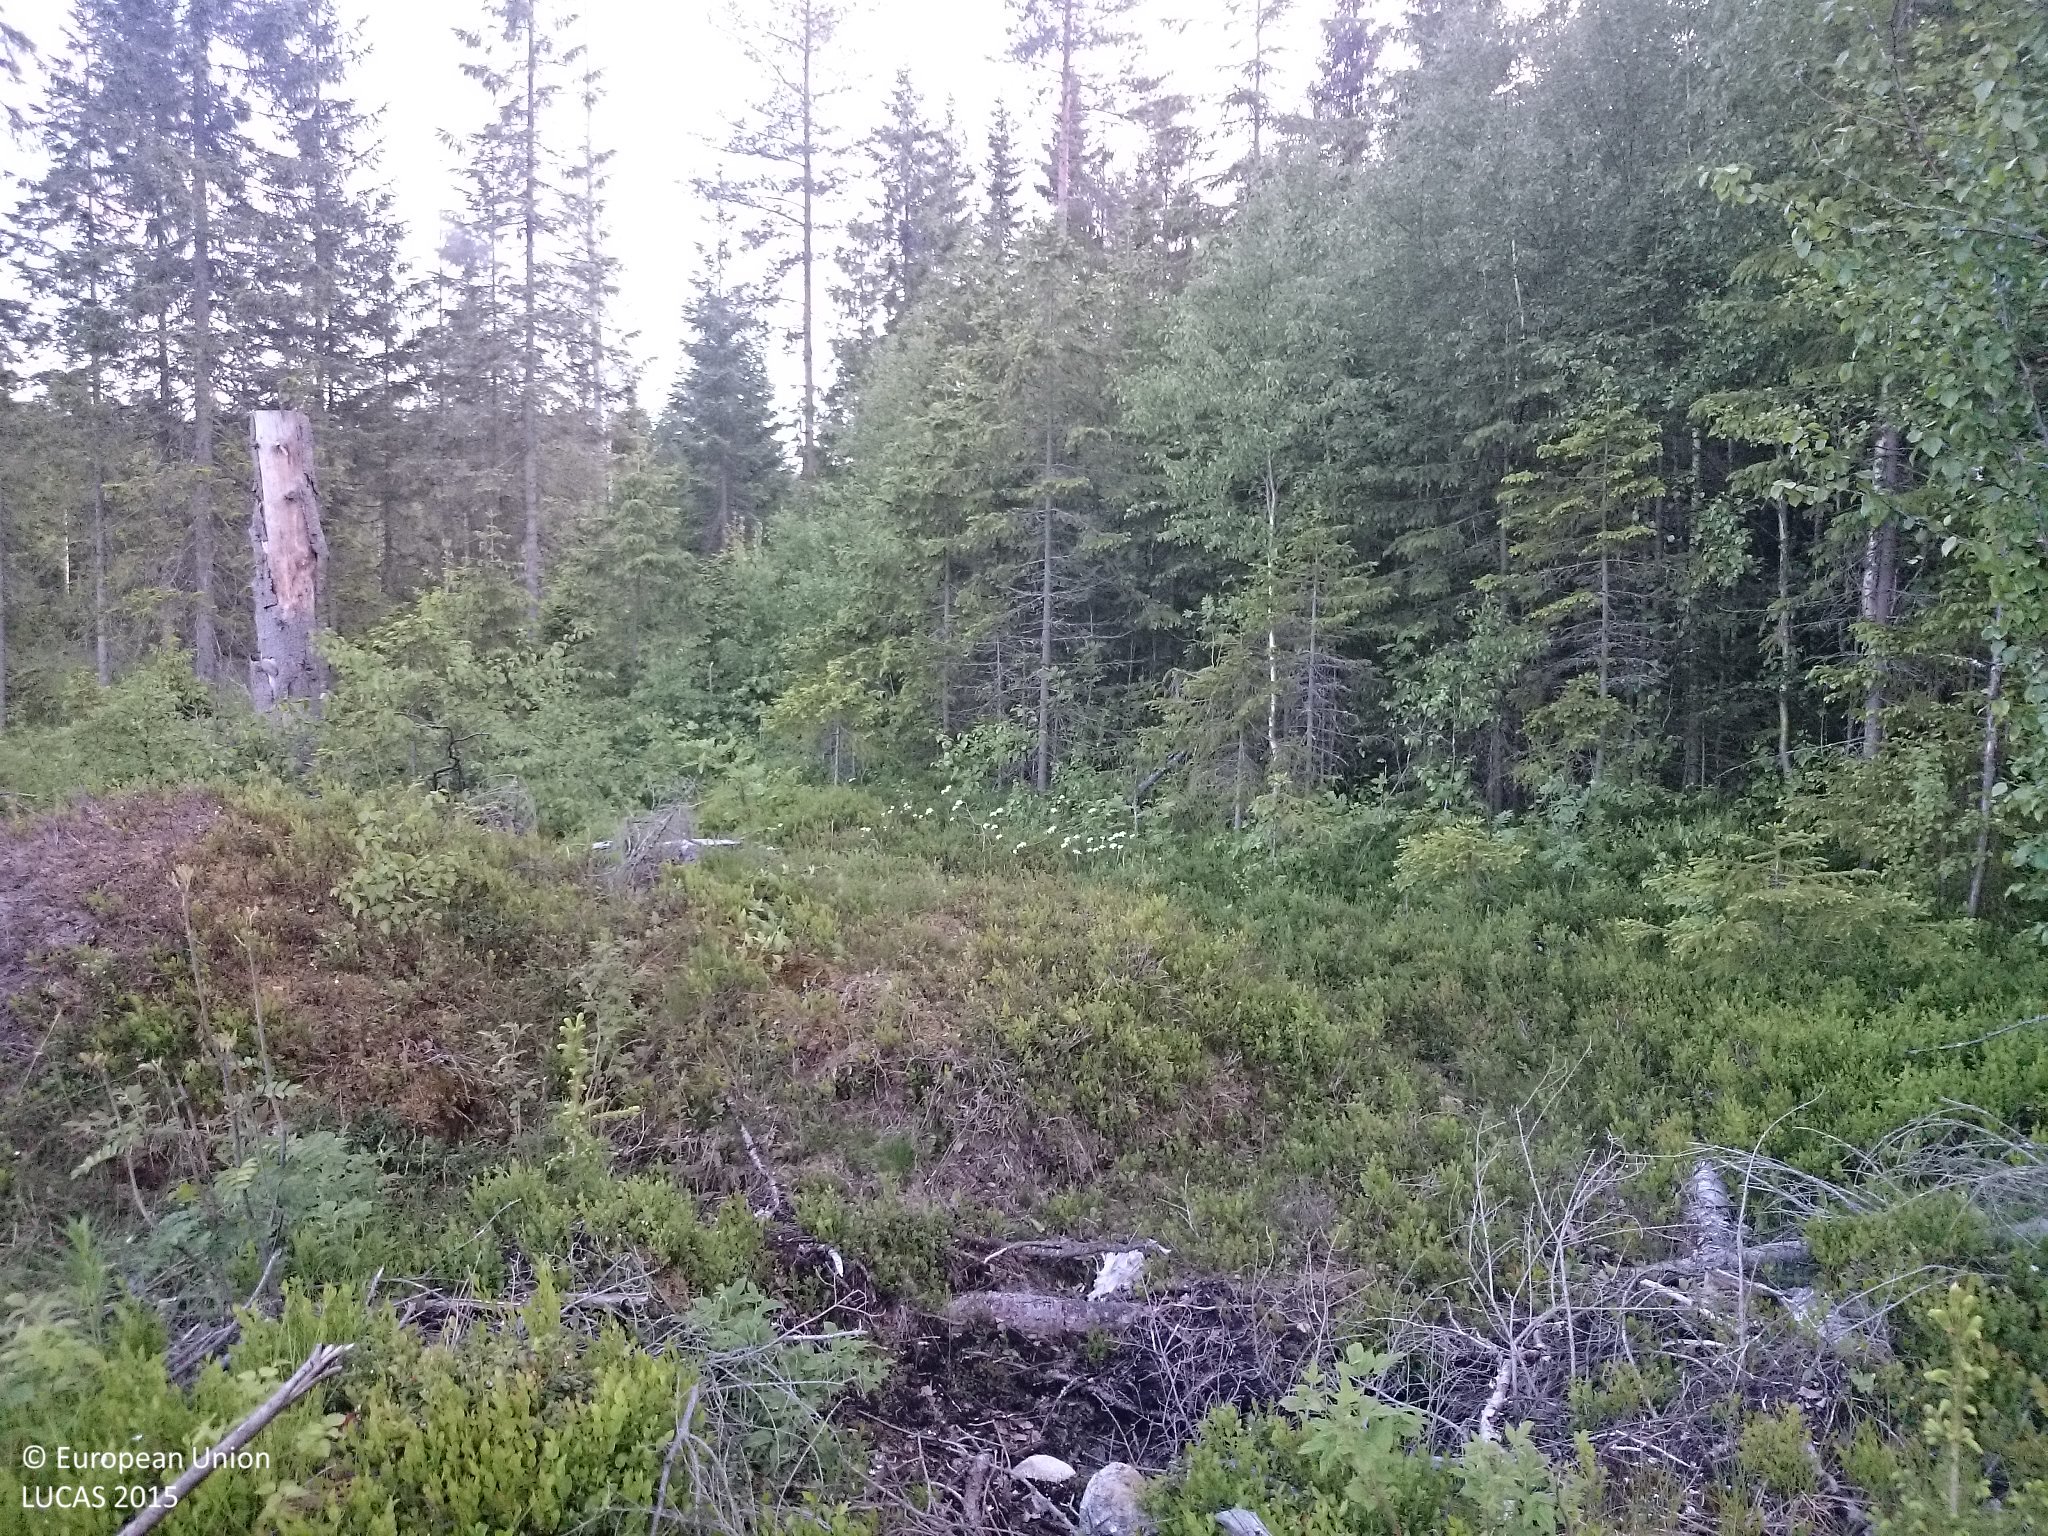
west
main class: Woodland
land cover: Broadleaved woodland
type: boreal forest
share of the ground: > 75 %
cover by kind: shrubs 45 %, herbaceous plants 40 %, broadleaved forest trees 15 %
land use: Forestry
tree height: < 5 m
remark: Clear cut
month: June
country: SE
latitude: 64.2855
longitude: 20.7848
